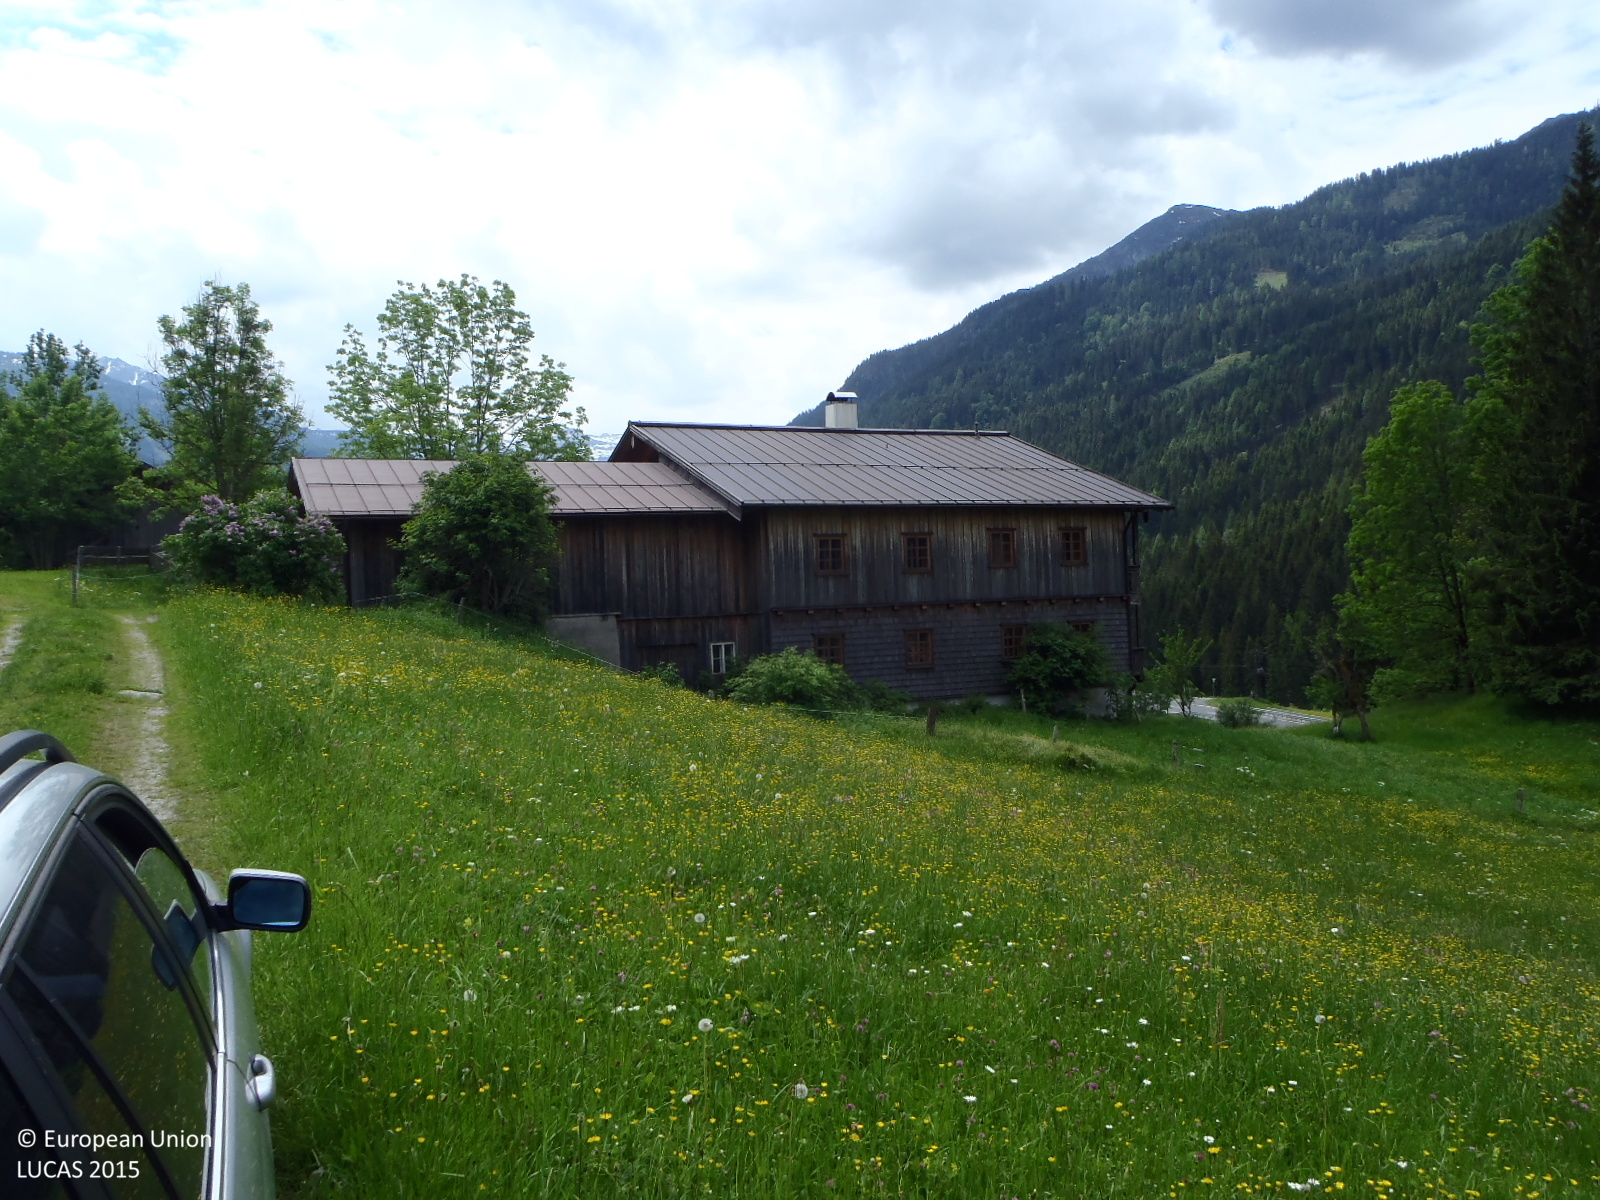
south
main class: Grassland
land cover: Grassland without tree/shrub cover
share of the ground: > 75 %
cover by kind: herbaceous plants 100 %
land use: Agriculture (excluding fallow land and kitchen gardens)
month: June
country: AT
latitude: 47.3391
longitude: 13.5054
